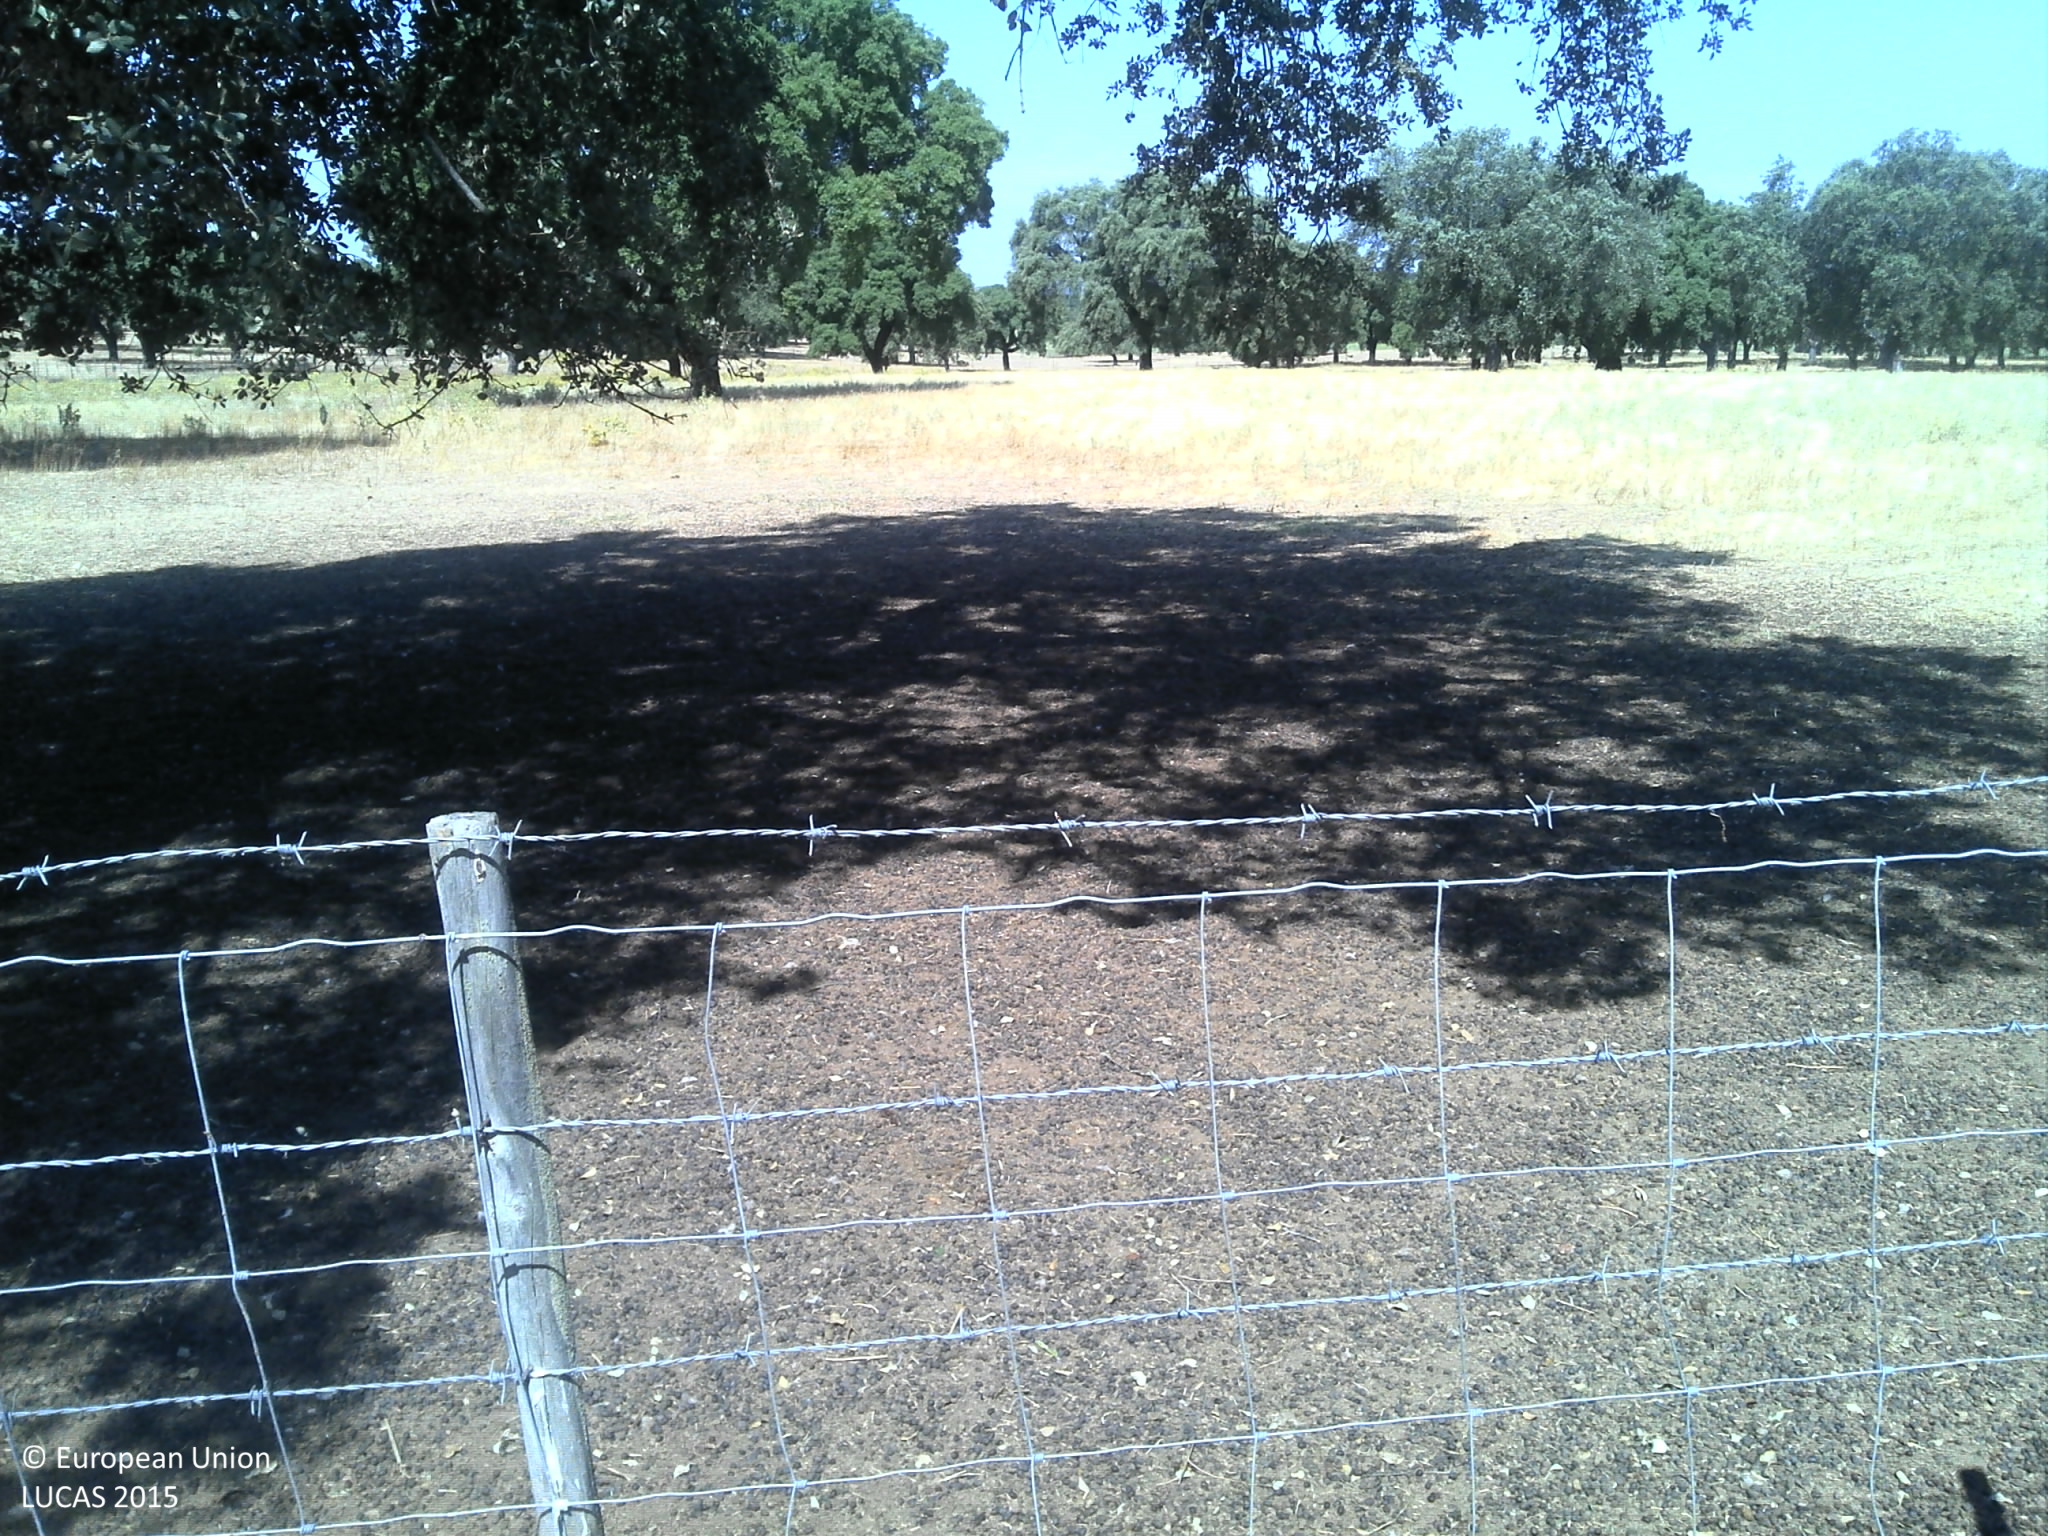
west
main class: Woodland
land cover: Broadleaved woodland
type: broadleaved evergreen forest
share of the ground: 25 - 50 %
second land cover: Grassland without tree/shrub cover
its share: 25 - 50 %
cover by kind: broadleaved forest trees 40 %, herbaceous plants 40 %, unconsolidated bare surface 15 %
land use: Forestry
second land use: Agriculture (excluding fallow land and kitchen gardens)
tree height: > 5 m
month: June
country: PT
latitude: 39.9036
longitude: -7.0624
